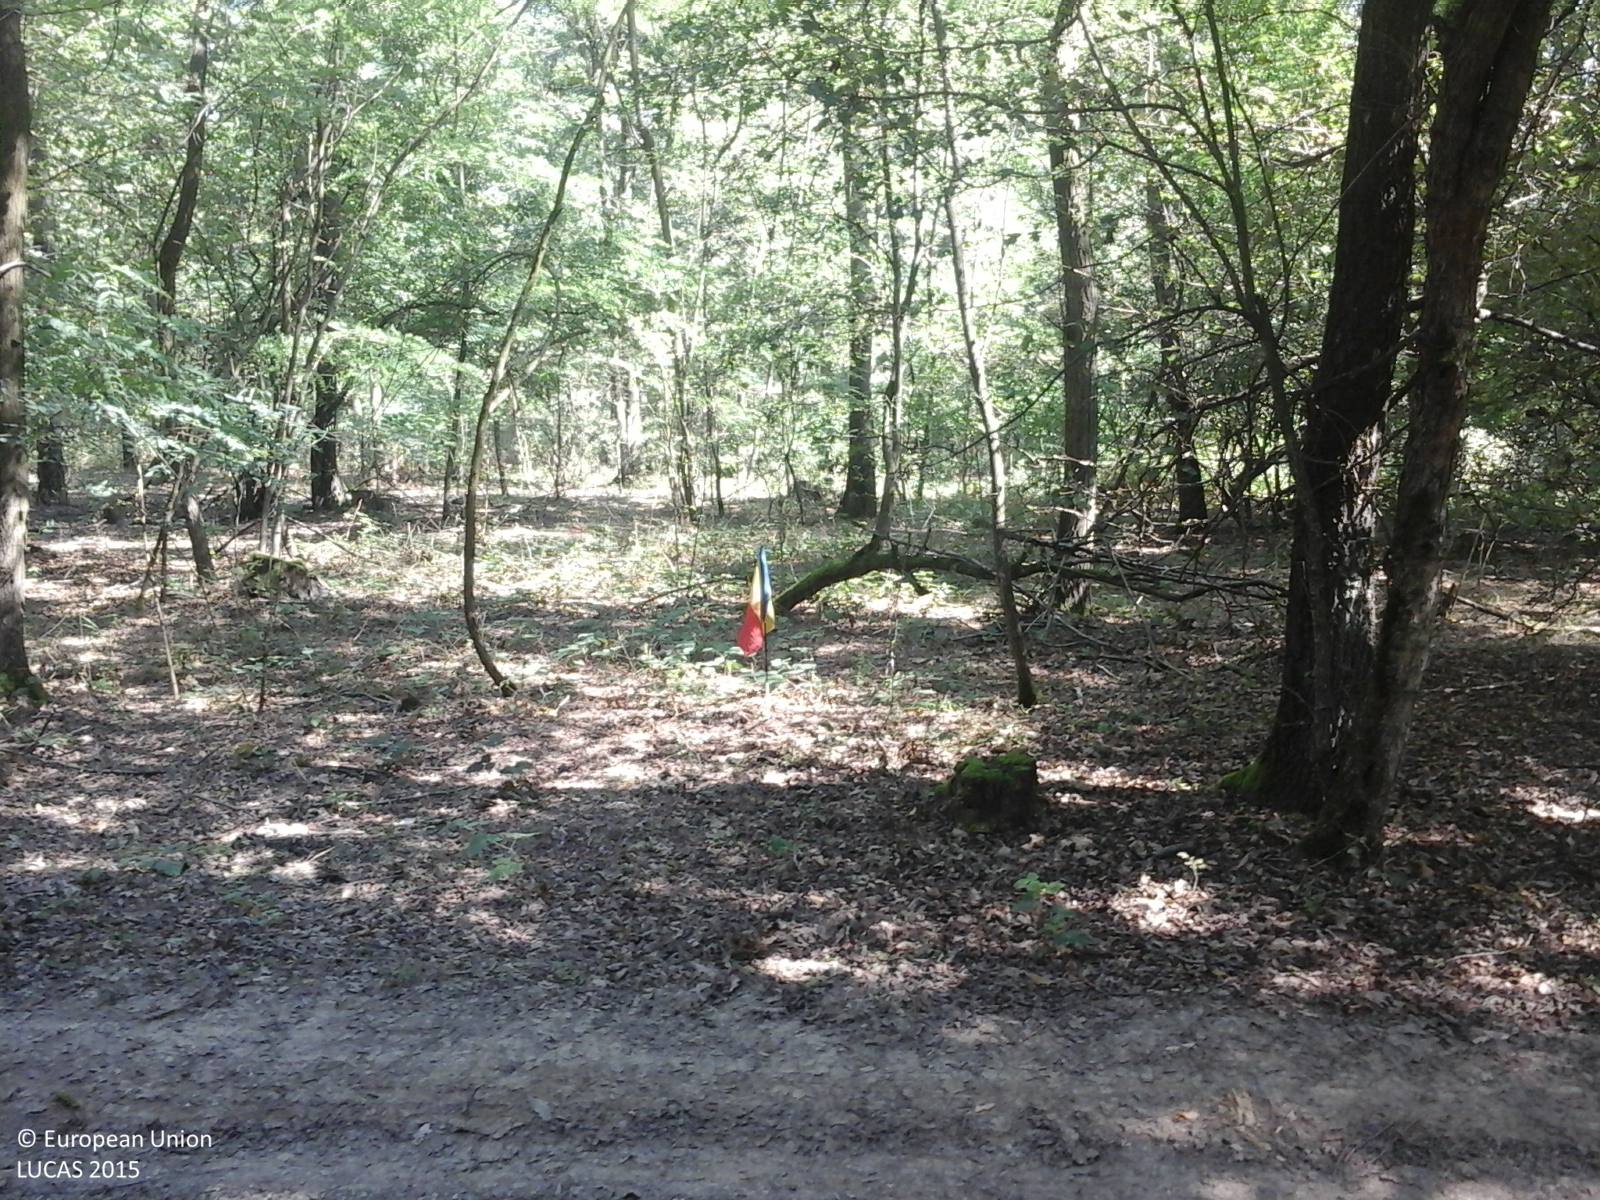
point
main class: Woodland
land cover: Broadleaved woodland
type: acidophilous oak and oak-birch forest
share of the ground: > 75 %
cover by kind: broadleaved forest trees 100 %
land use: Forestry
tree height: > 5 m
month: September
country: RO
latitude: 47.3545
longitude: 22.7293
